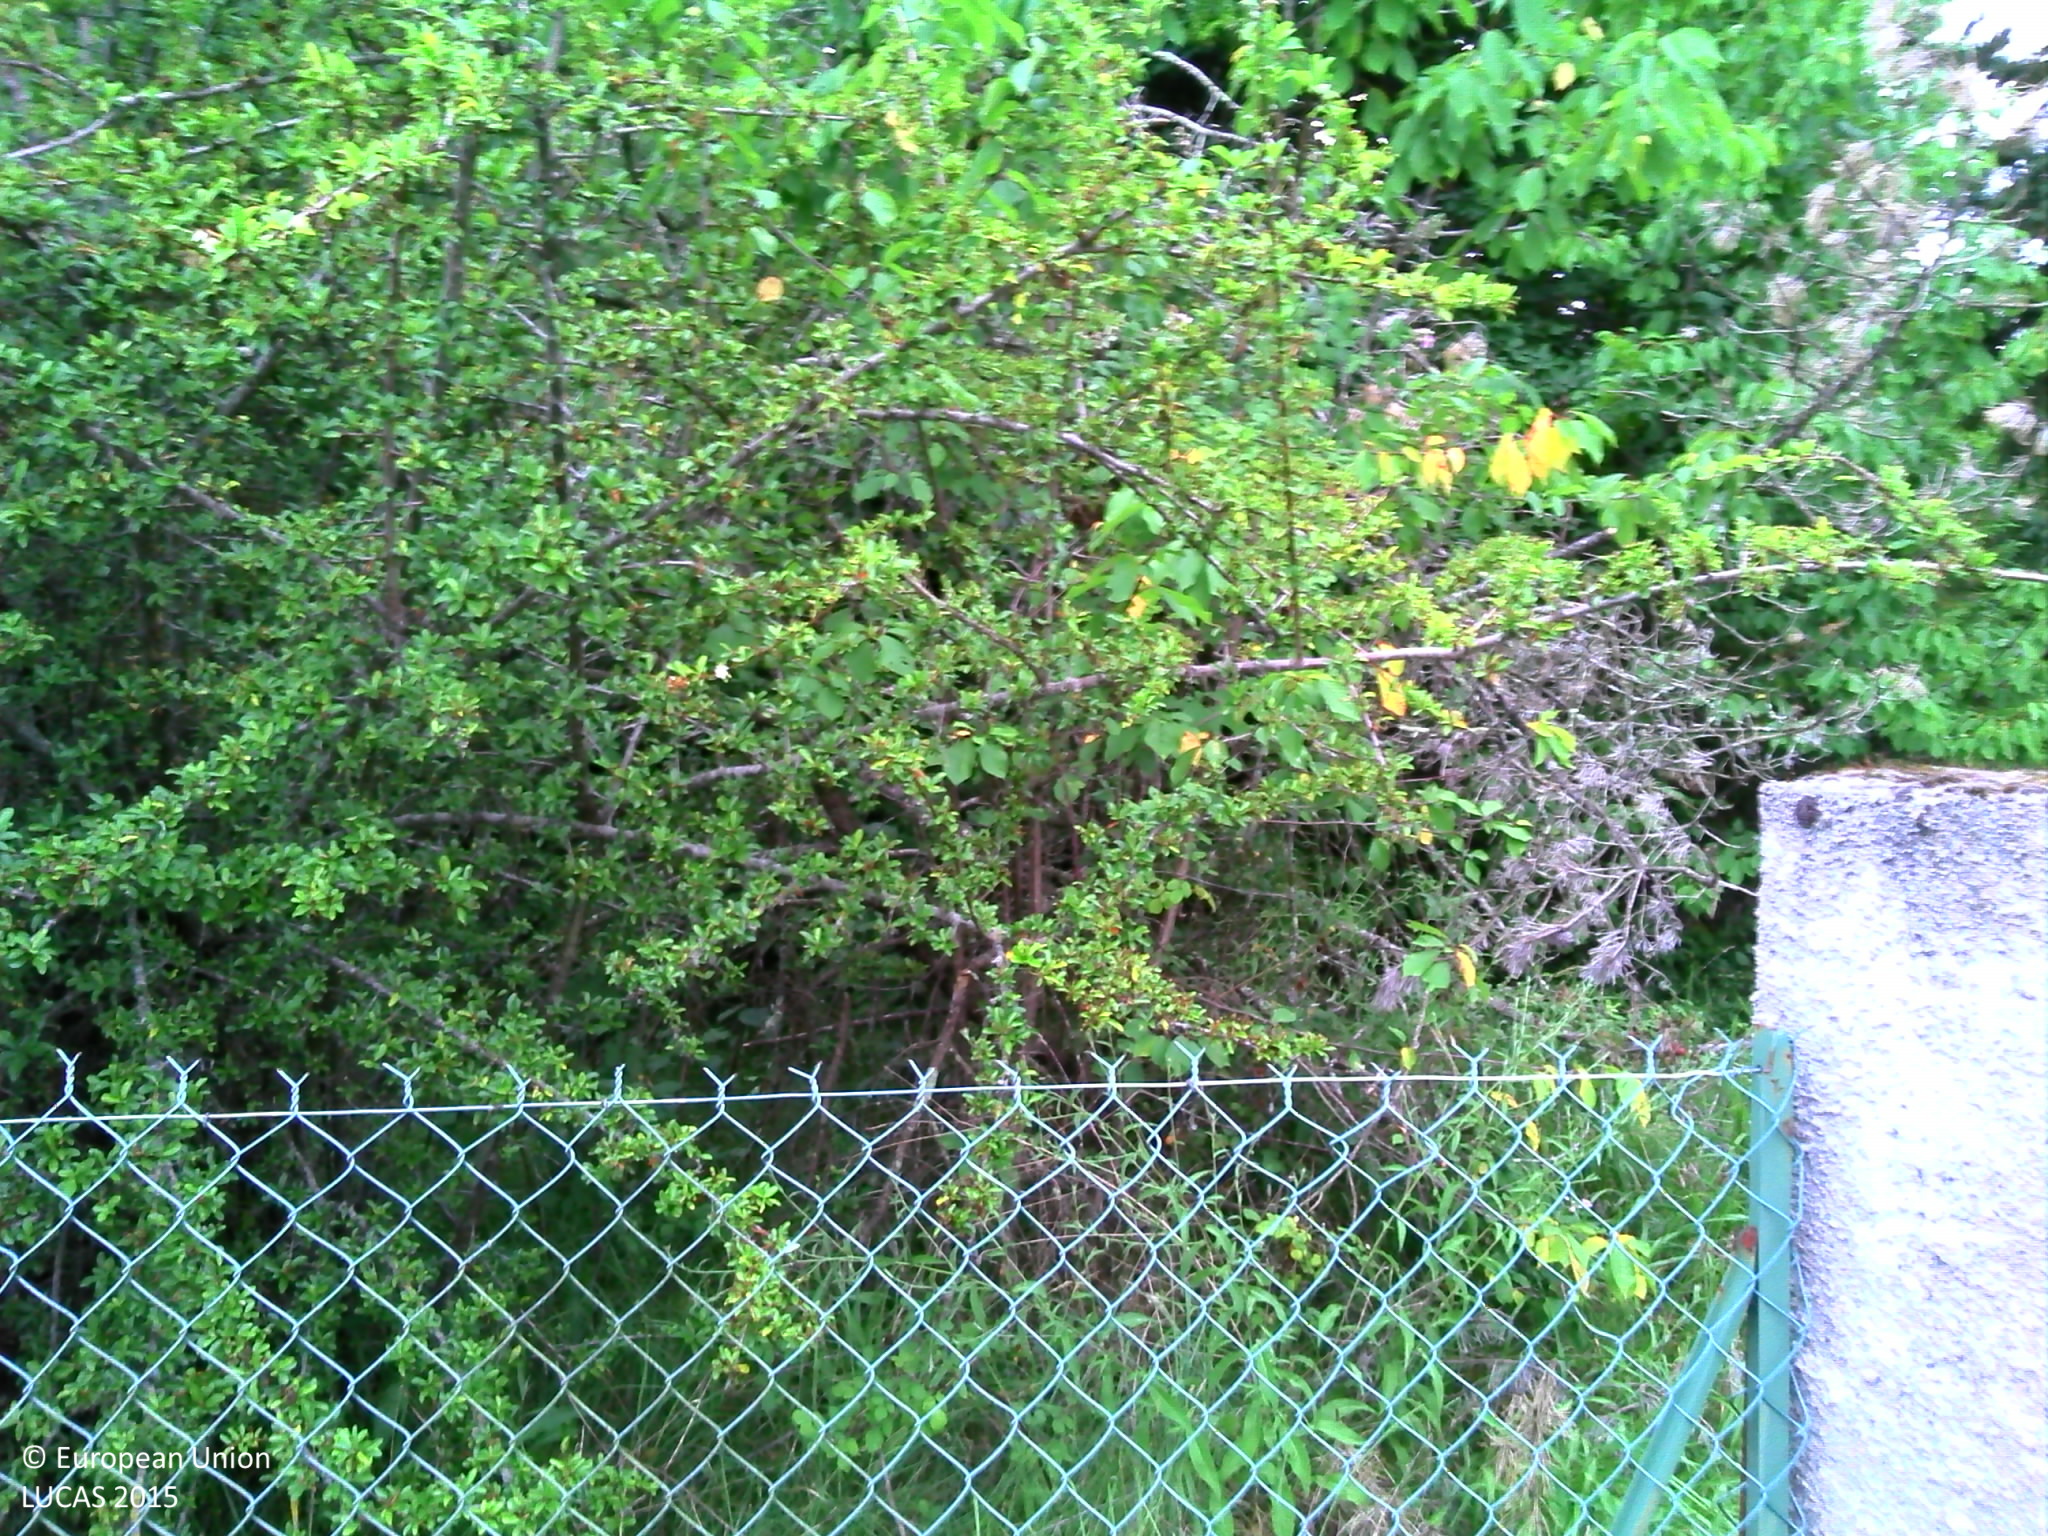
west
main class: Woodland
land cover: Spruce dominated mixed woodland
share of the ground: > 75 %
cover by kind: broadleaved forest trees 50 %, coniferous forest trees 30 %, shrubs 10 %, herbaceous plants 10 %
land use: Residential
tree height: > 5 m
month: July
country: FR
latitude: 43.1218
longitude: 0.7715
